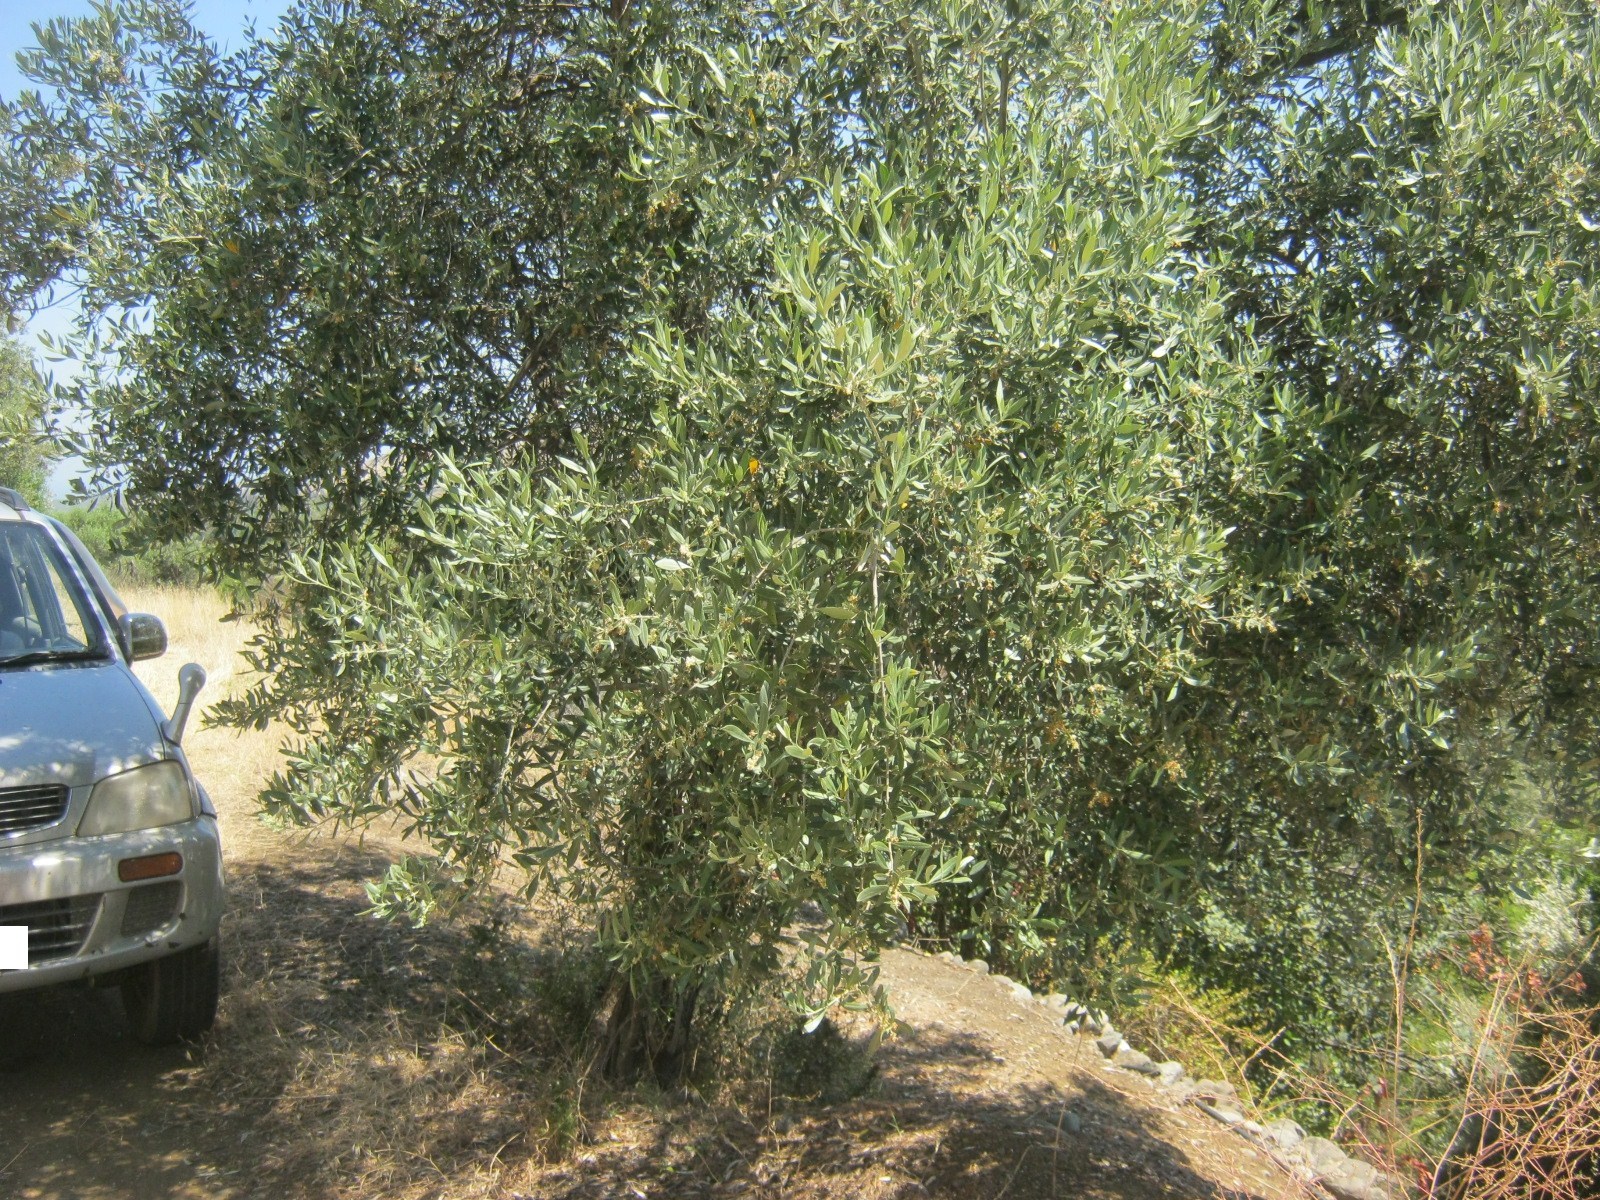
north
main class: Cropland
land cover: Olive groves
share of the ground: 50 - 75 %
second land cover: Grassland without tree/shrub cover
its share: > 75 %
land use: Agriculture (excluding fallow land and kitchen gardens)
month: May
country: CY
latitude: 35.0678
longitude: 32.8817
